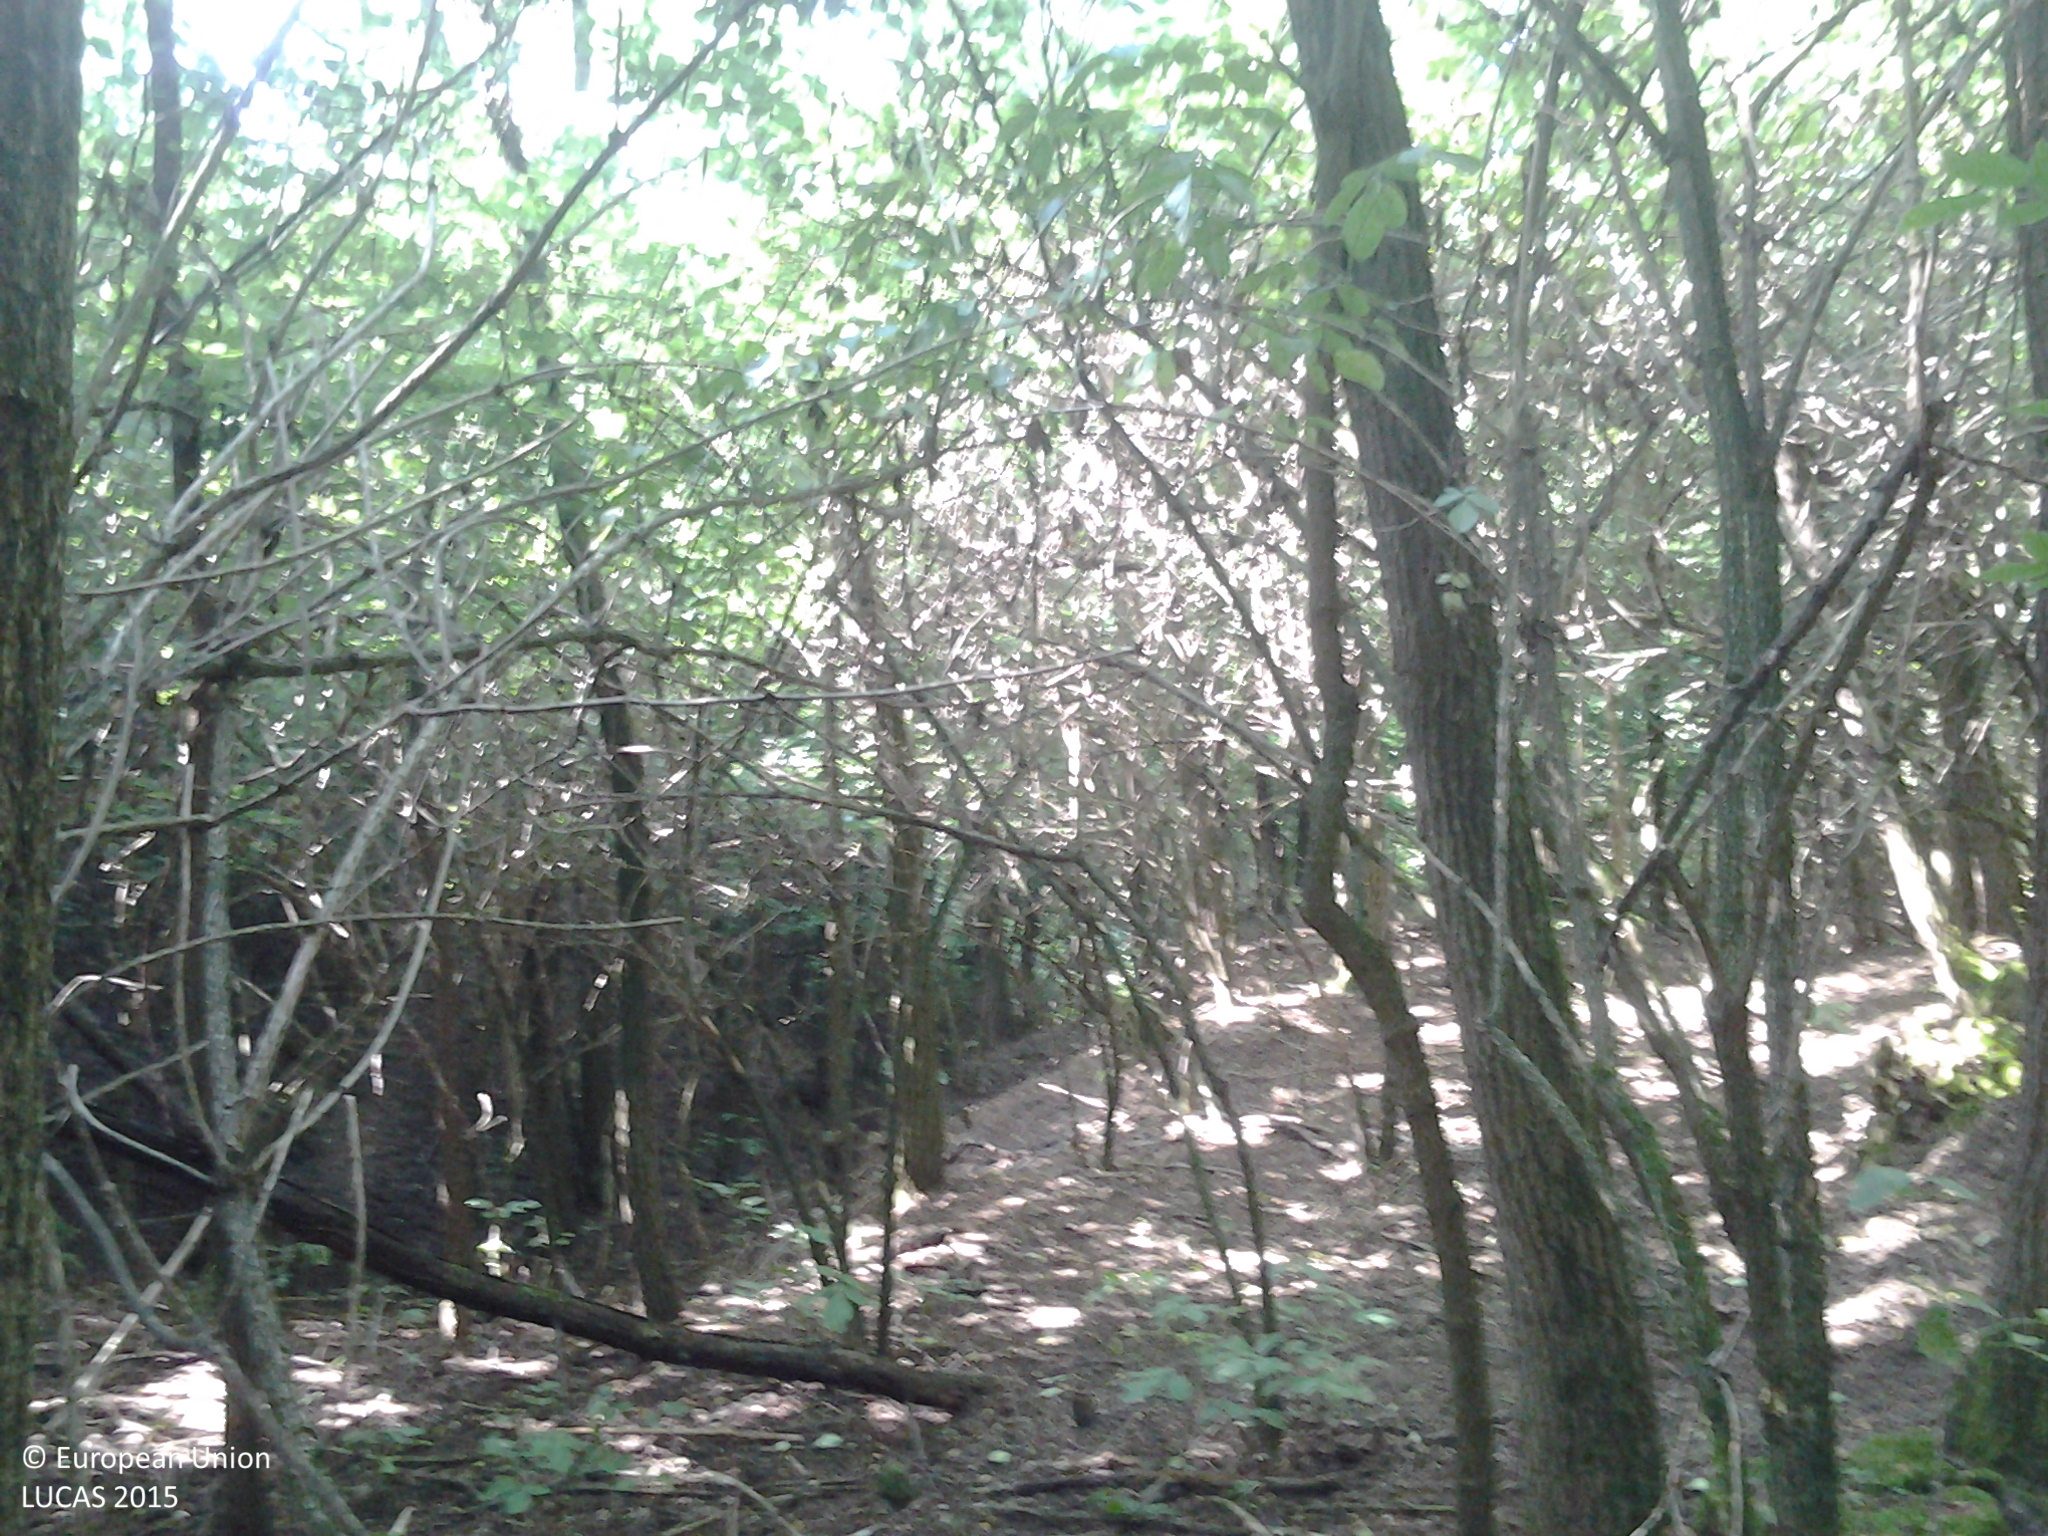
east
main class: Woodland
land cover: Broadleaved woodland
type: mesophytic deciduous forest
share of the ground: > 75 %
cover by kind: broadleaved forest trees 80 %, shrubs 20 %
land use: Forestry
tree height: > 5 m
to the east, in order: Broadleaved woodland; Tracks; Grassland without tree/shrub cover; Broadleaved woodland
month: August
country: HU
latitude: 48.0095
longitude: 19.9337
